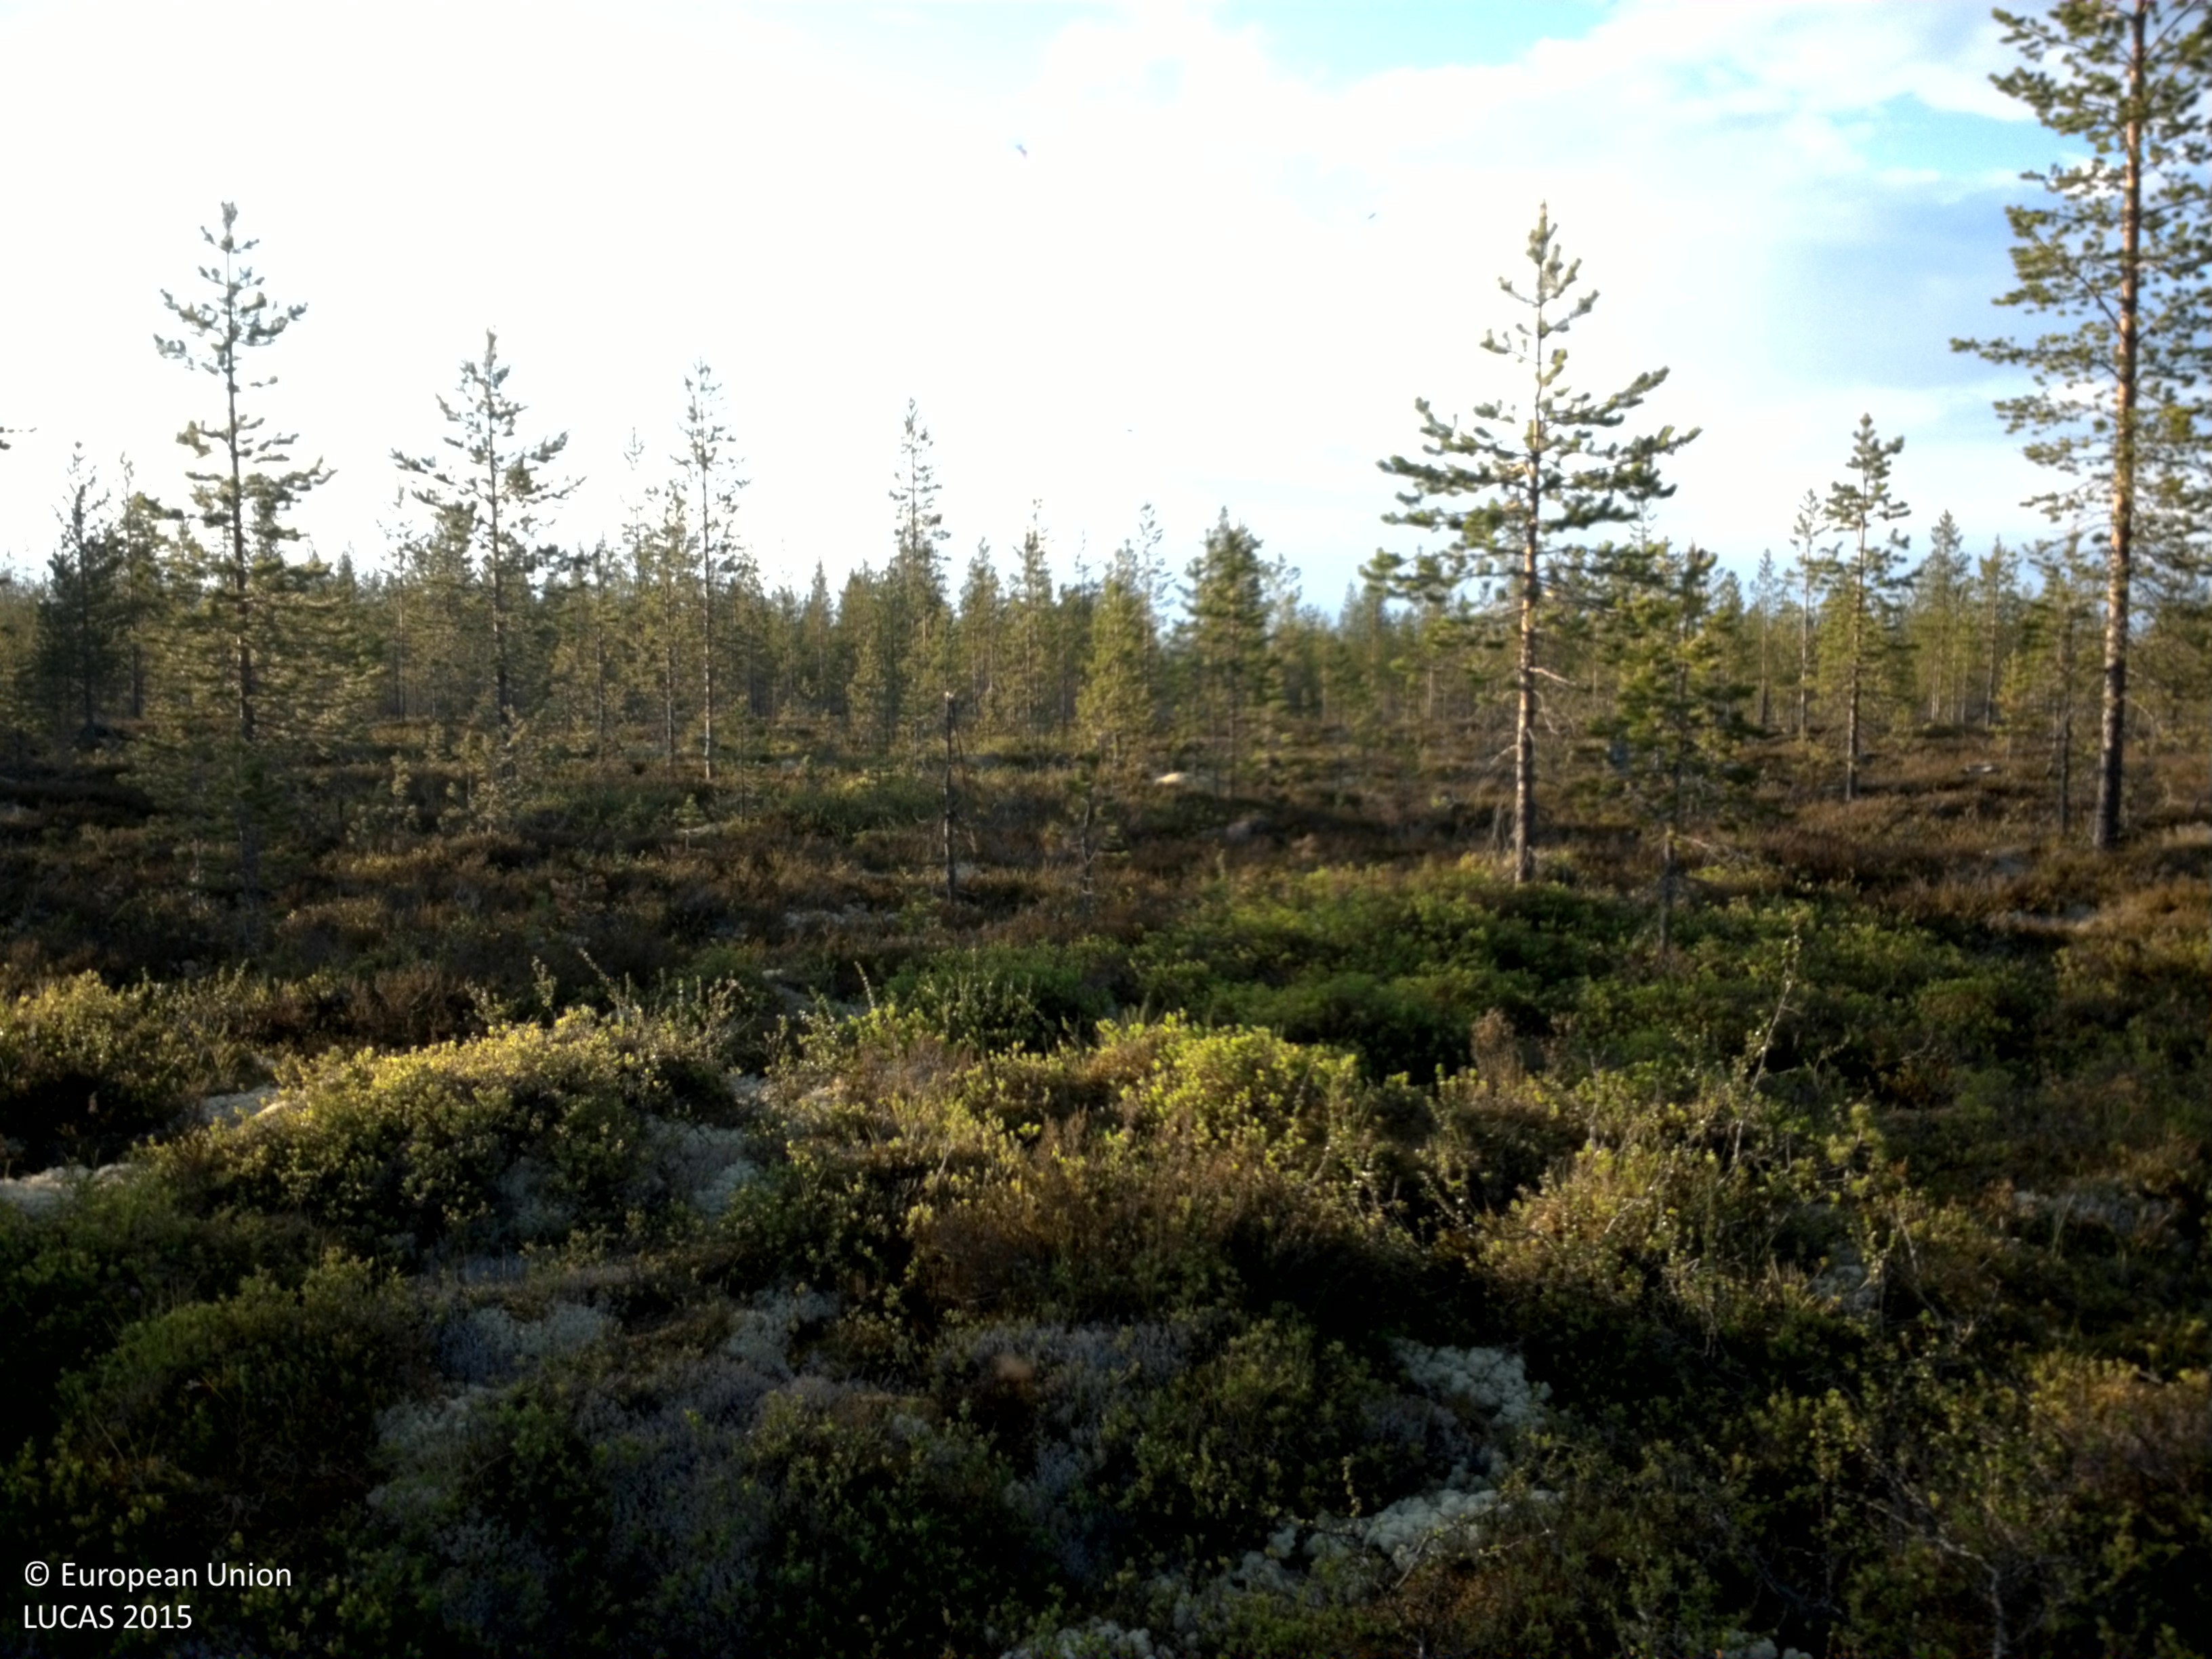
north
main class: Woodland
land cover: Pine dominated coniferous woodland
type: boreal forest
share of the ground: 10 - 25 %
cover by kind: shrubs 60 %, coniferous forest trees 25 %, lichens and mosses 15 %
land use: Forestry
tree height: > 5 m
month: June
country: SE
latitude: 61.8152
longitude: 12.5517
